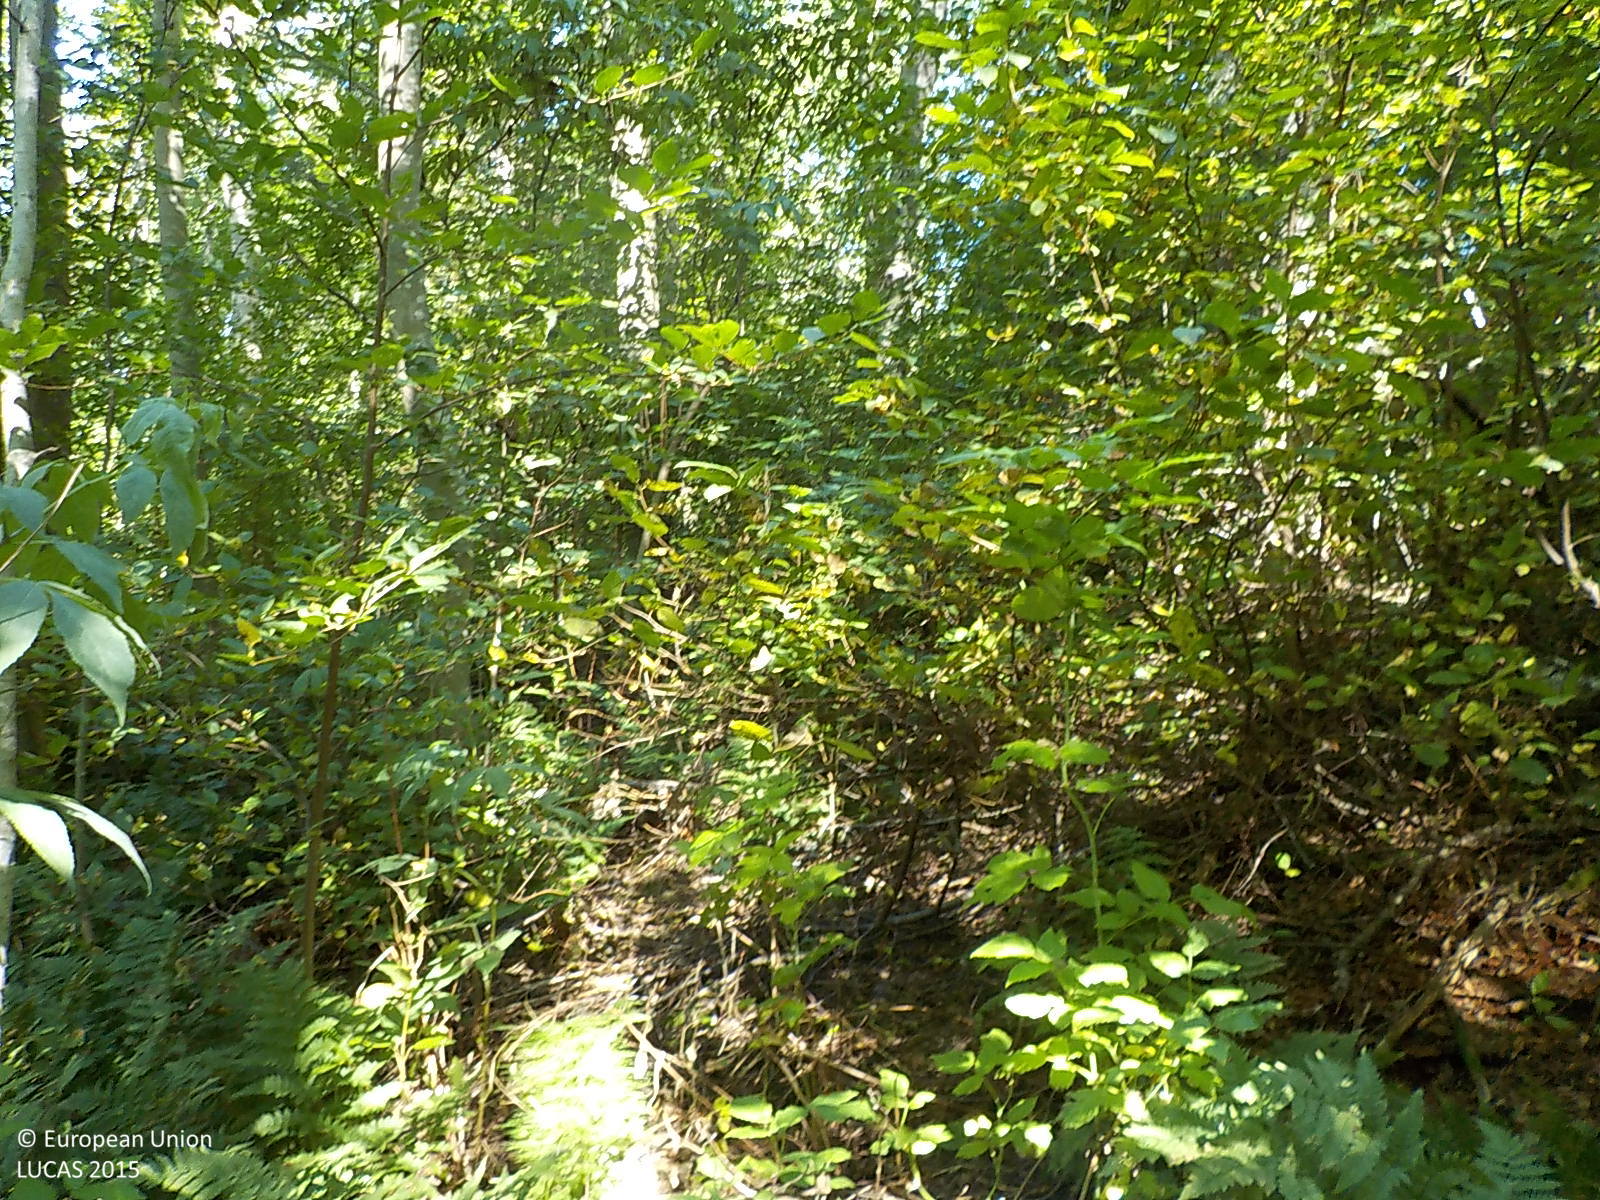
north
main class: Woodland
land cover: Broadleaved woodland
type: hemiboreal forest and nemoral coniferous forest and mixed broadleaved-coniferous forest
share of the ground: > 75 %
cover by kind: broadleaved forest trees 95 %, herbaceous plants 5 %
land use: Forestry
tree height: > 5 m
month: August
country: SE
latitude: 63.3251
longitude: 18.6630
